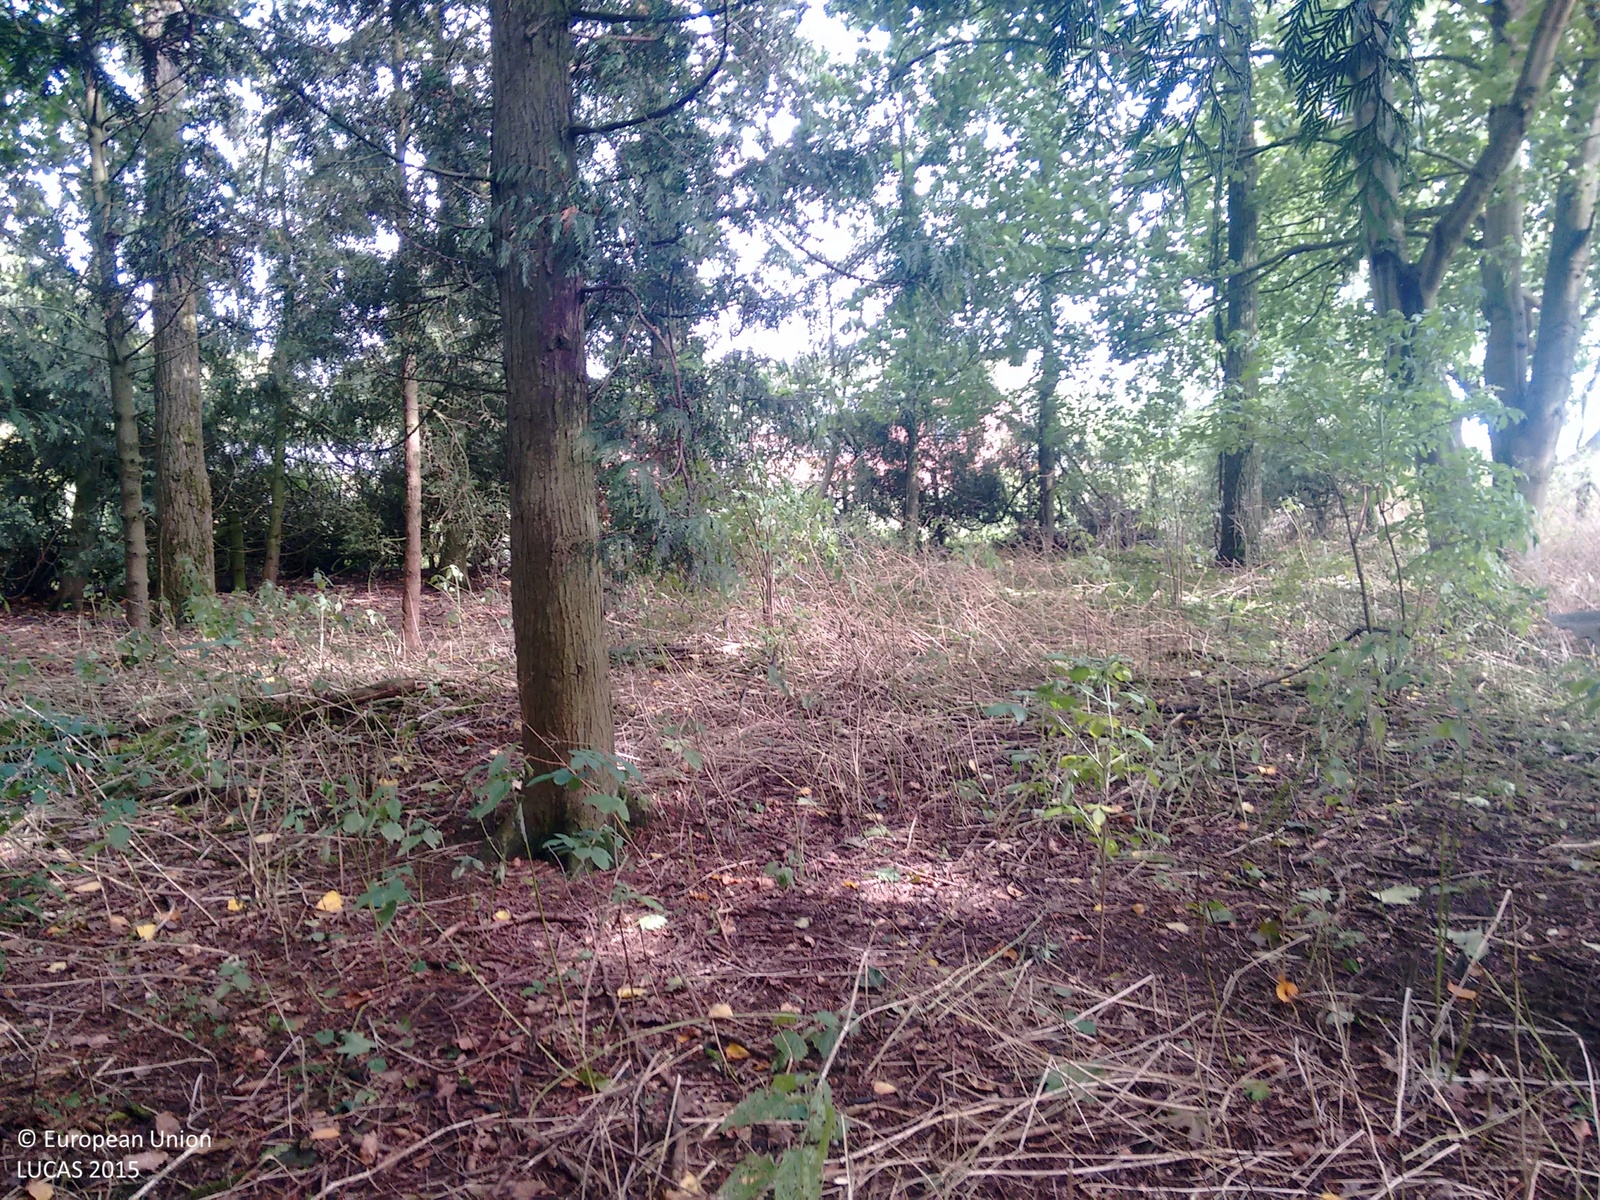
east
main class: Woodland
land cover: Other coniferous woodland
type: exotic forest
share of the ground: > 75 %
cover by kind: coniferous forest trees 85 %, shrubs 10 %, broadleaved forest trees 5 %
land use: Semi-natural and natural areas not in use
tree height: > 5 m
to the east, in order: Other coniferous woodland; Shruby margins; Tracks; Grass margins; Tracks; Grassland without tree/shrub cover; Abandoned hedges; Inland fresh running water; Abandoned hedges; Artificial constructions in urban areas; Conifer hedges; Inland fresh running water; Abandoned hedges; Grassland without tree/shrub cover; Tracks; Other bare soil; Artificial constructions in urban areas; Other bare soil
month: August
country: GB
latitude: 52.1598
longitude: 0.5146
